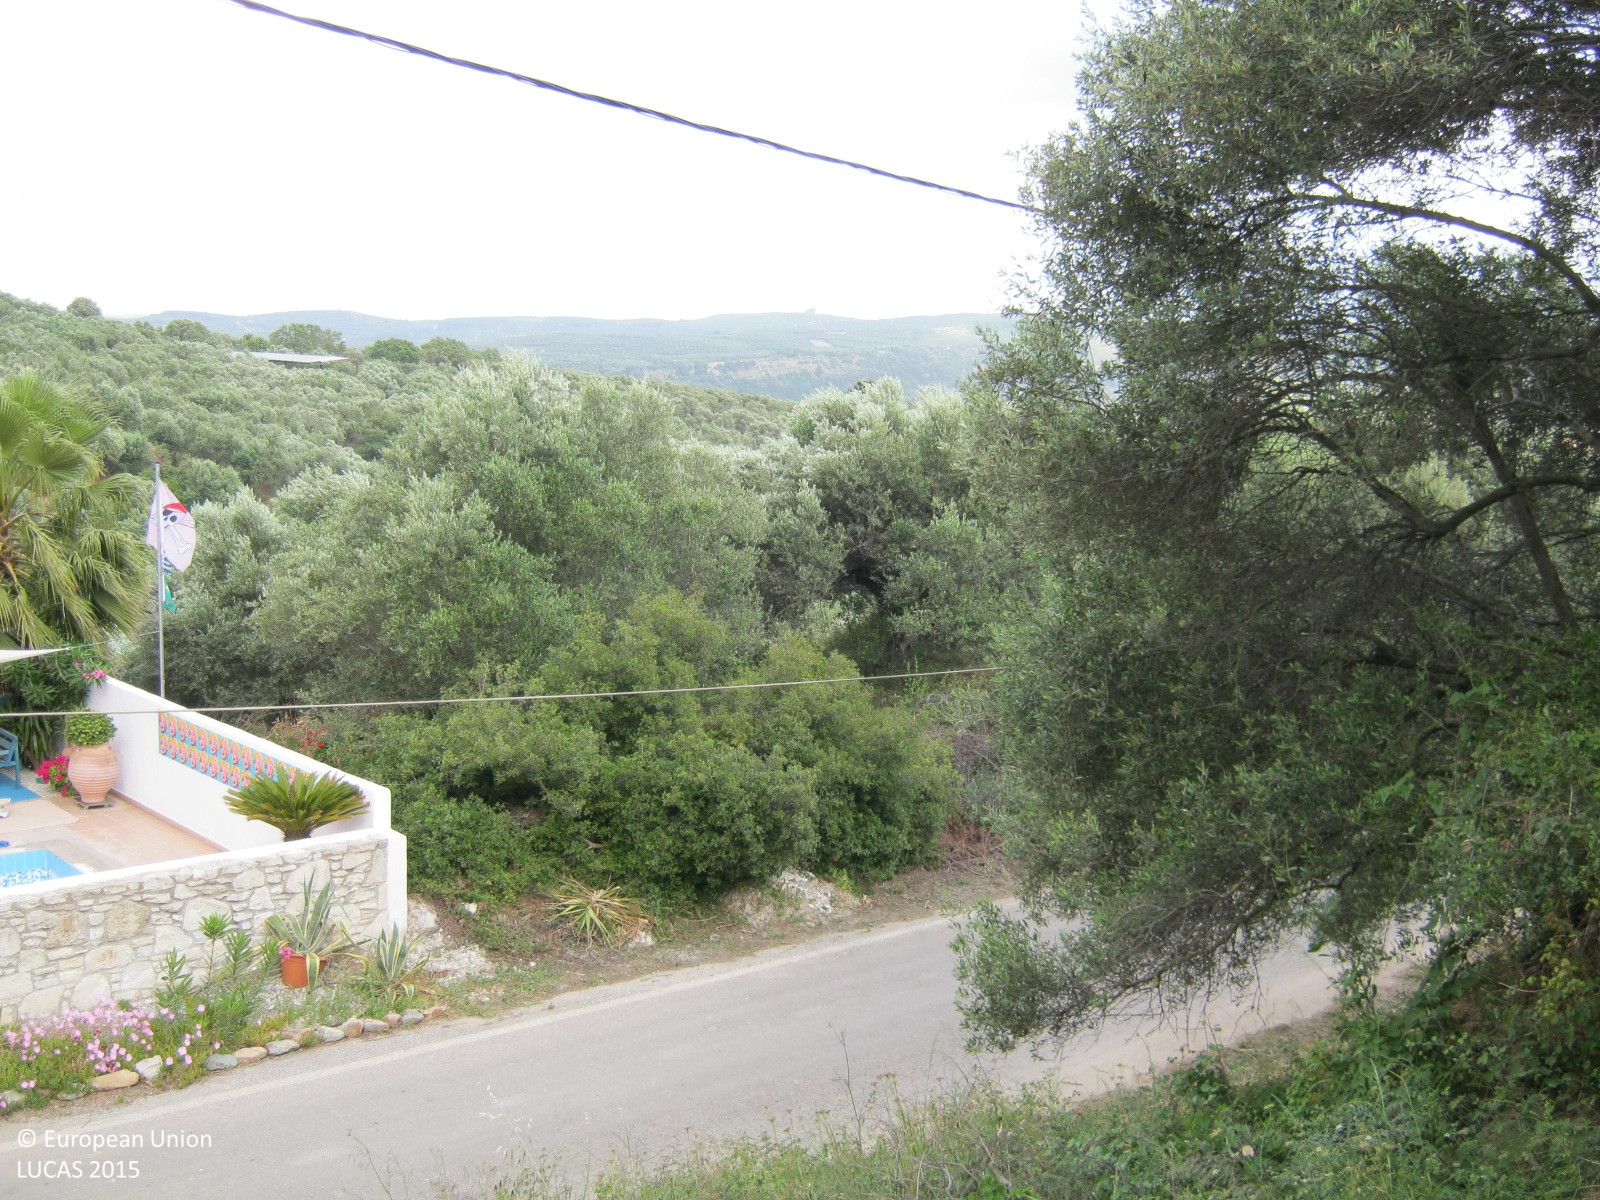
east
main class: Cropland
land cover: Olive groves
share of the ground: > 75 %
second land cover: Spontaneously vegetated surfaces
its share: > 75 %
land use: Agriculture (excluding fallow land and kitchen gardens)
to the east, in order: Olive groves; Spontaneously vegetated surfaces; Electric lines; Paved roads, cycling and walking lanes; Grass margins; Broadleaved woodland; Olive groves; Rivers and streams; Grassland with sparse tree/shrub cover; Olive groves
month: May
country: GR
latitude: 35.4867
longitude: 23.7949
